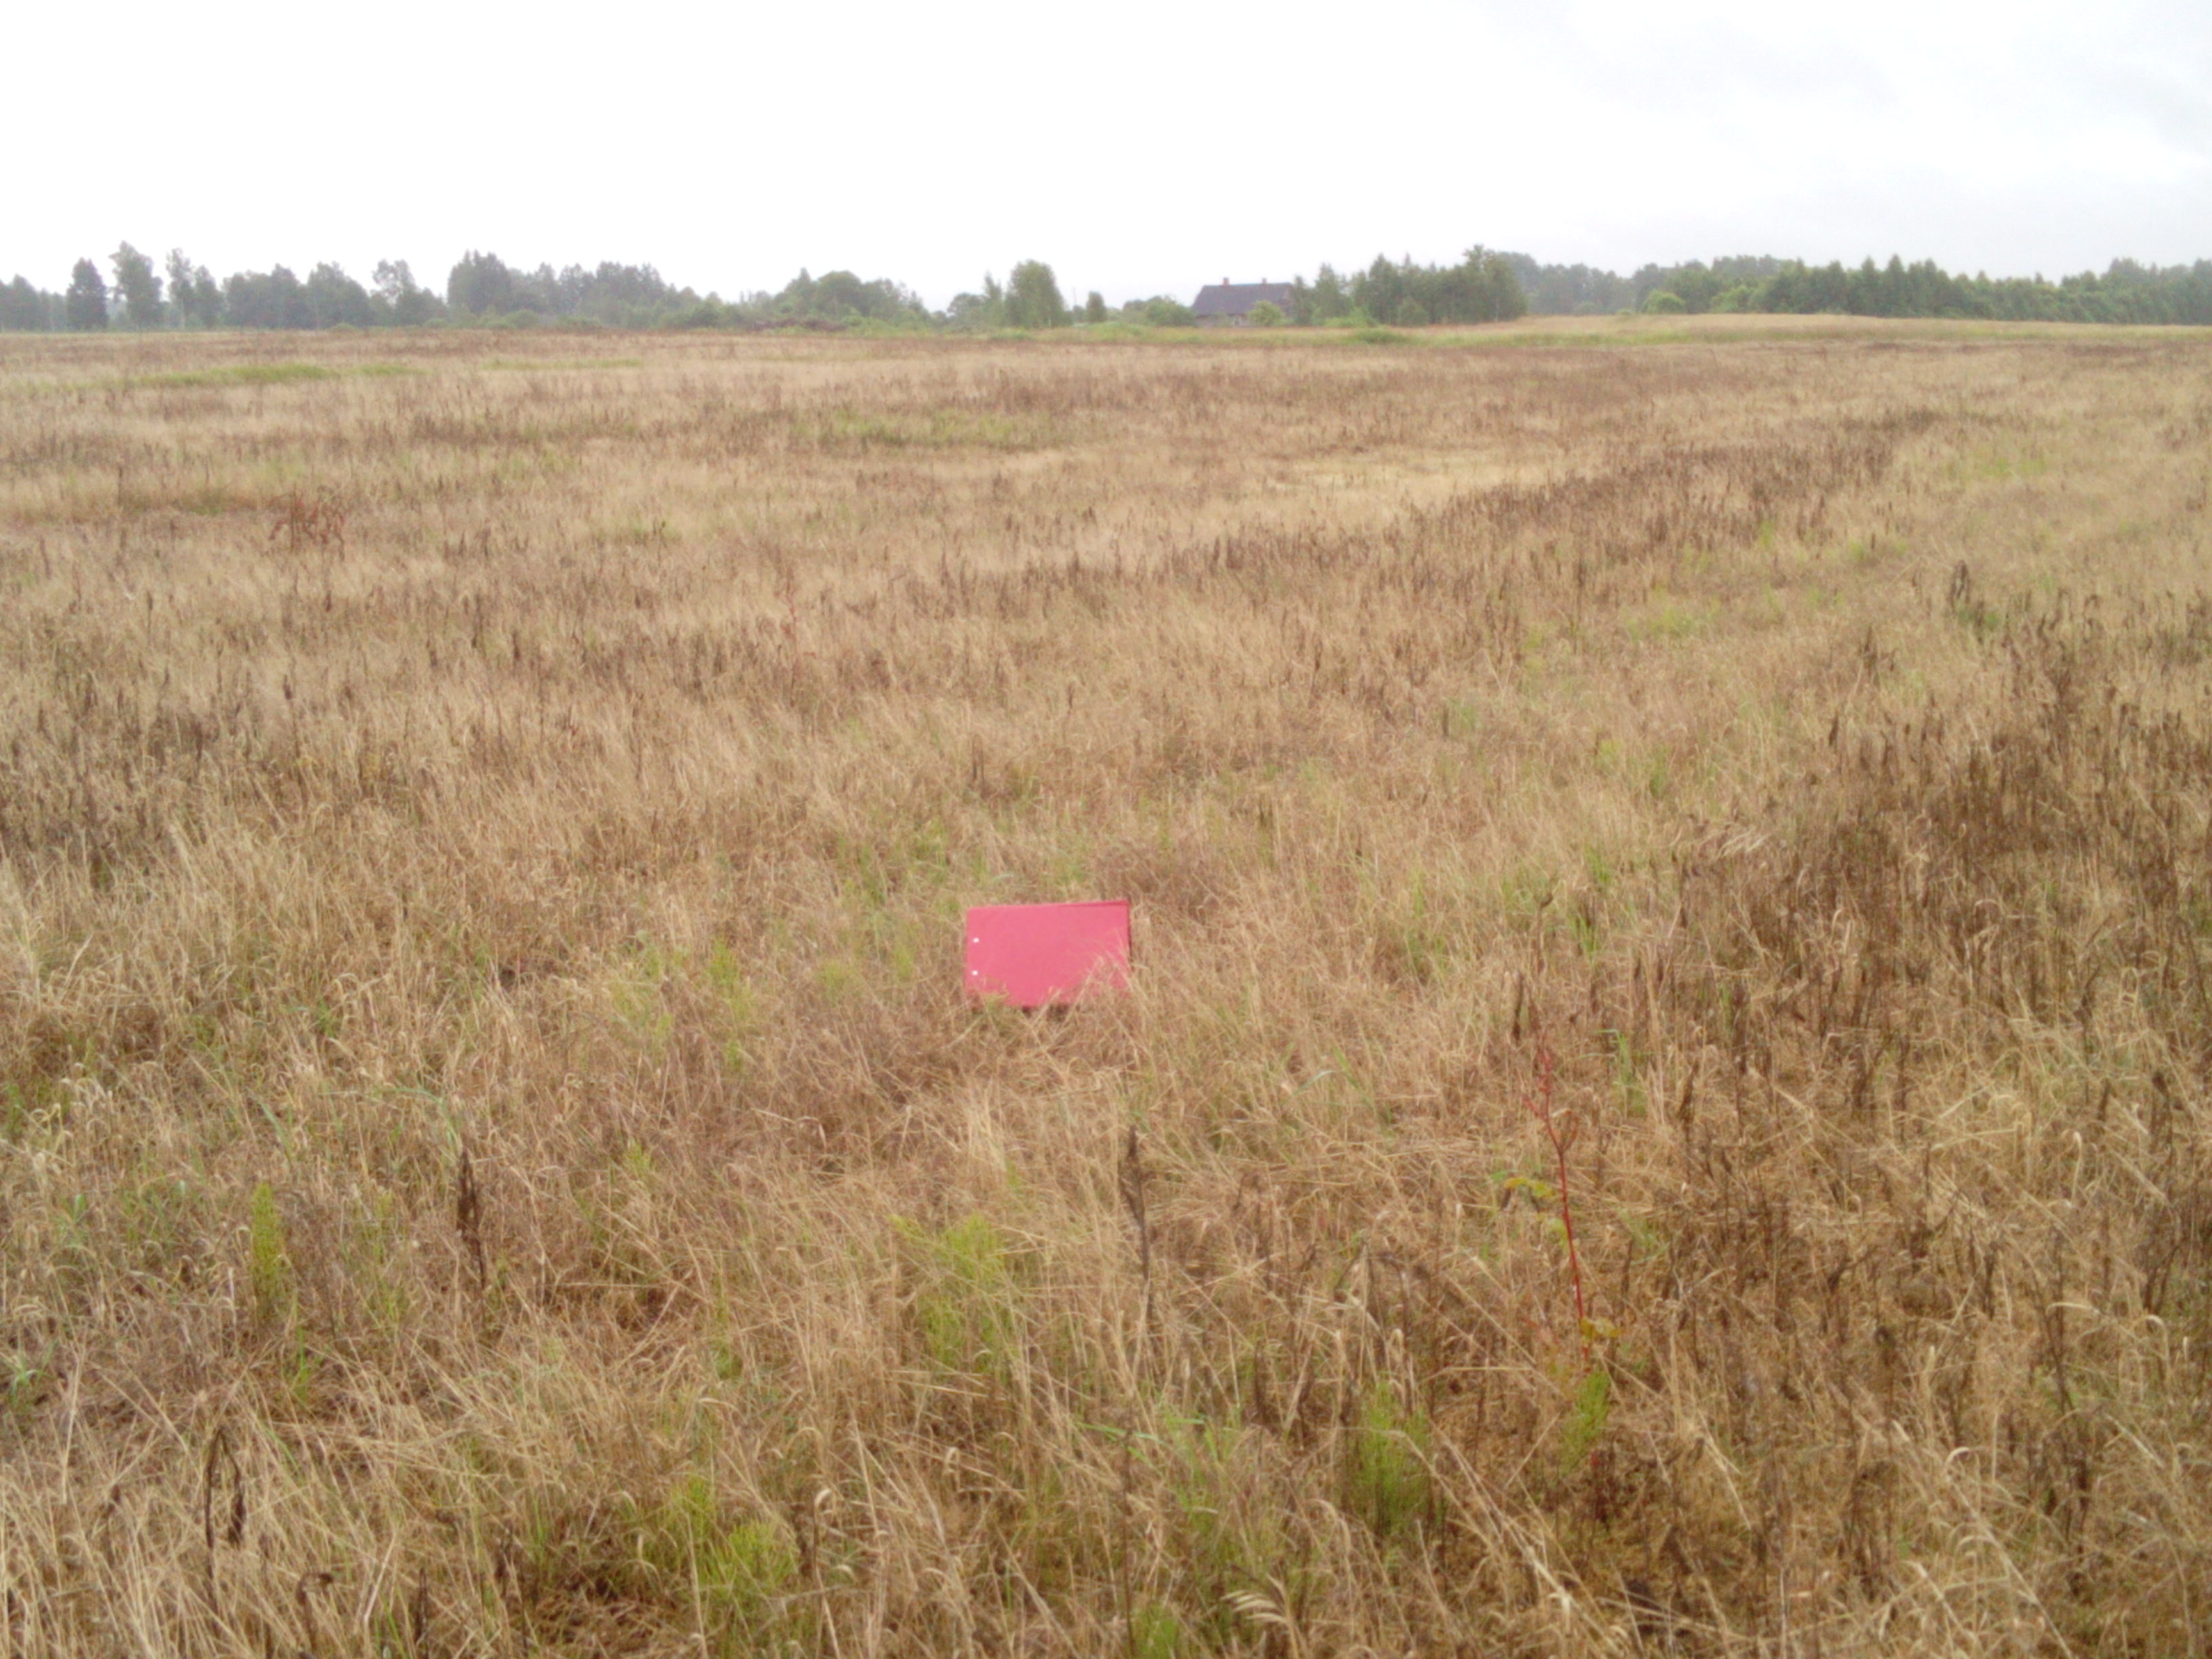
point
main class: Grassland
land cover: Grassland without tree/shrub cover
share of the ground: > 75 %
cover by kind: herbaceous plants 95 %, unconsolidated bare surface 5 %
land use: Agriculture (excluding fallow land and kitchen gardens)
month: July
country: LV
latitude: 57.0481
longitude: 22.1318
